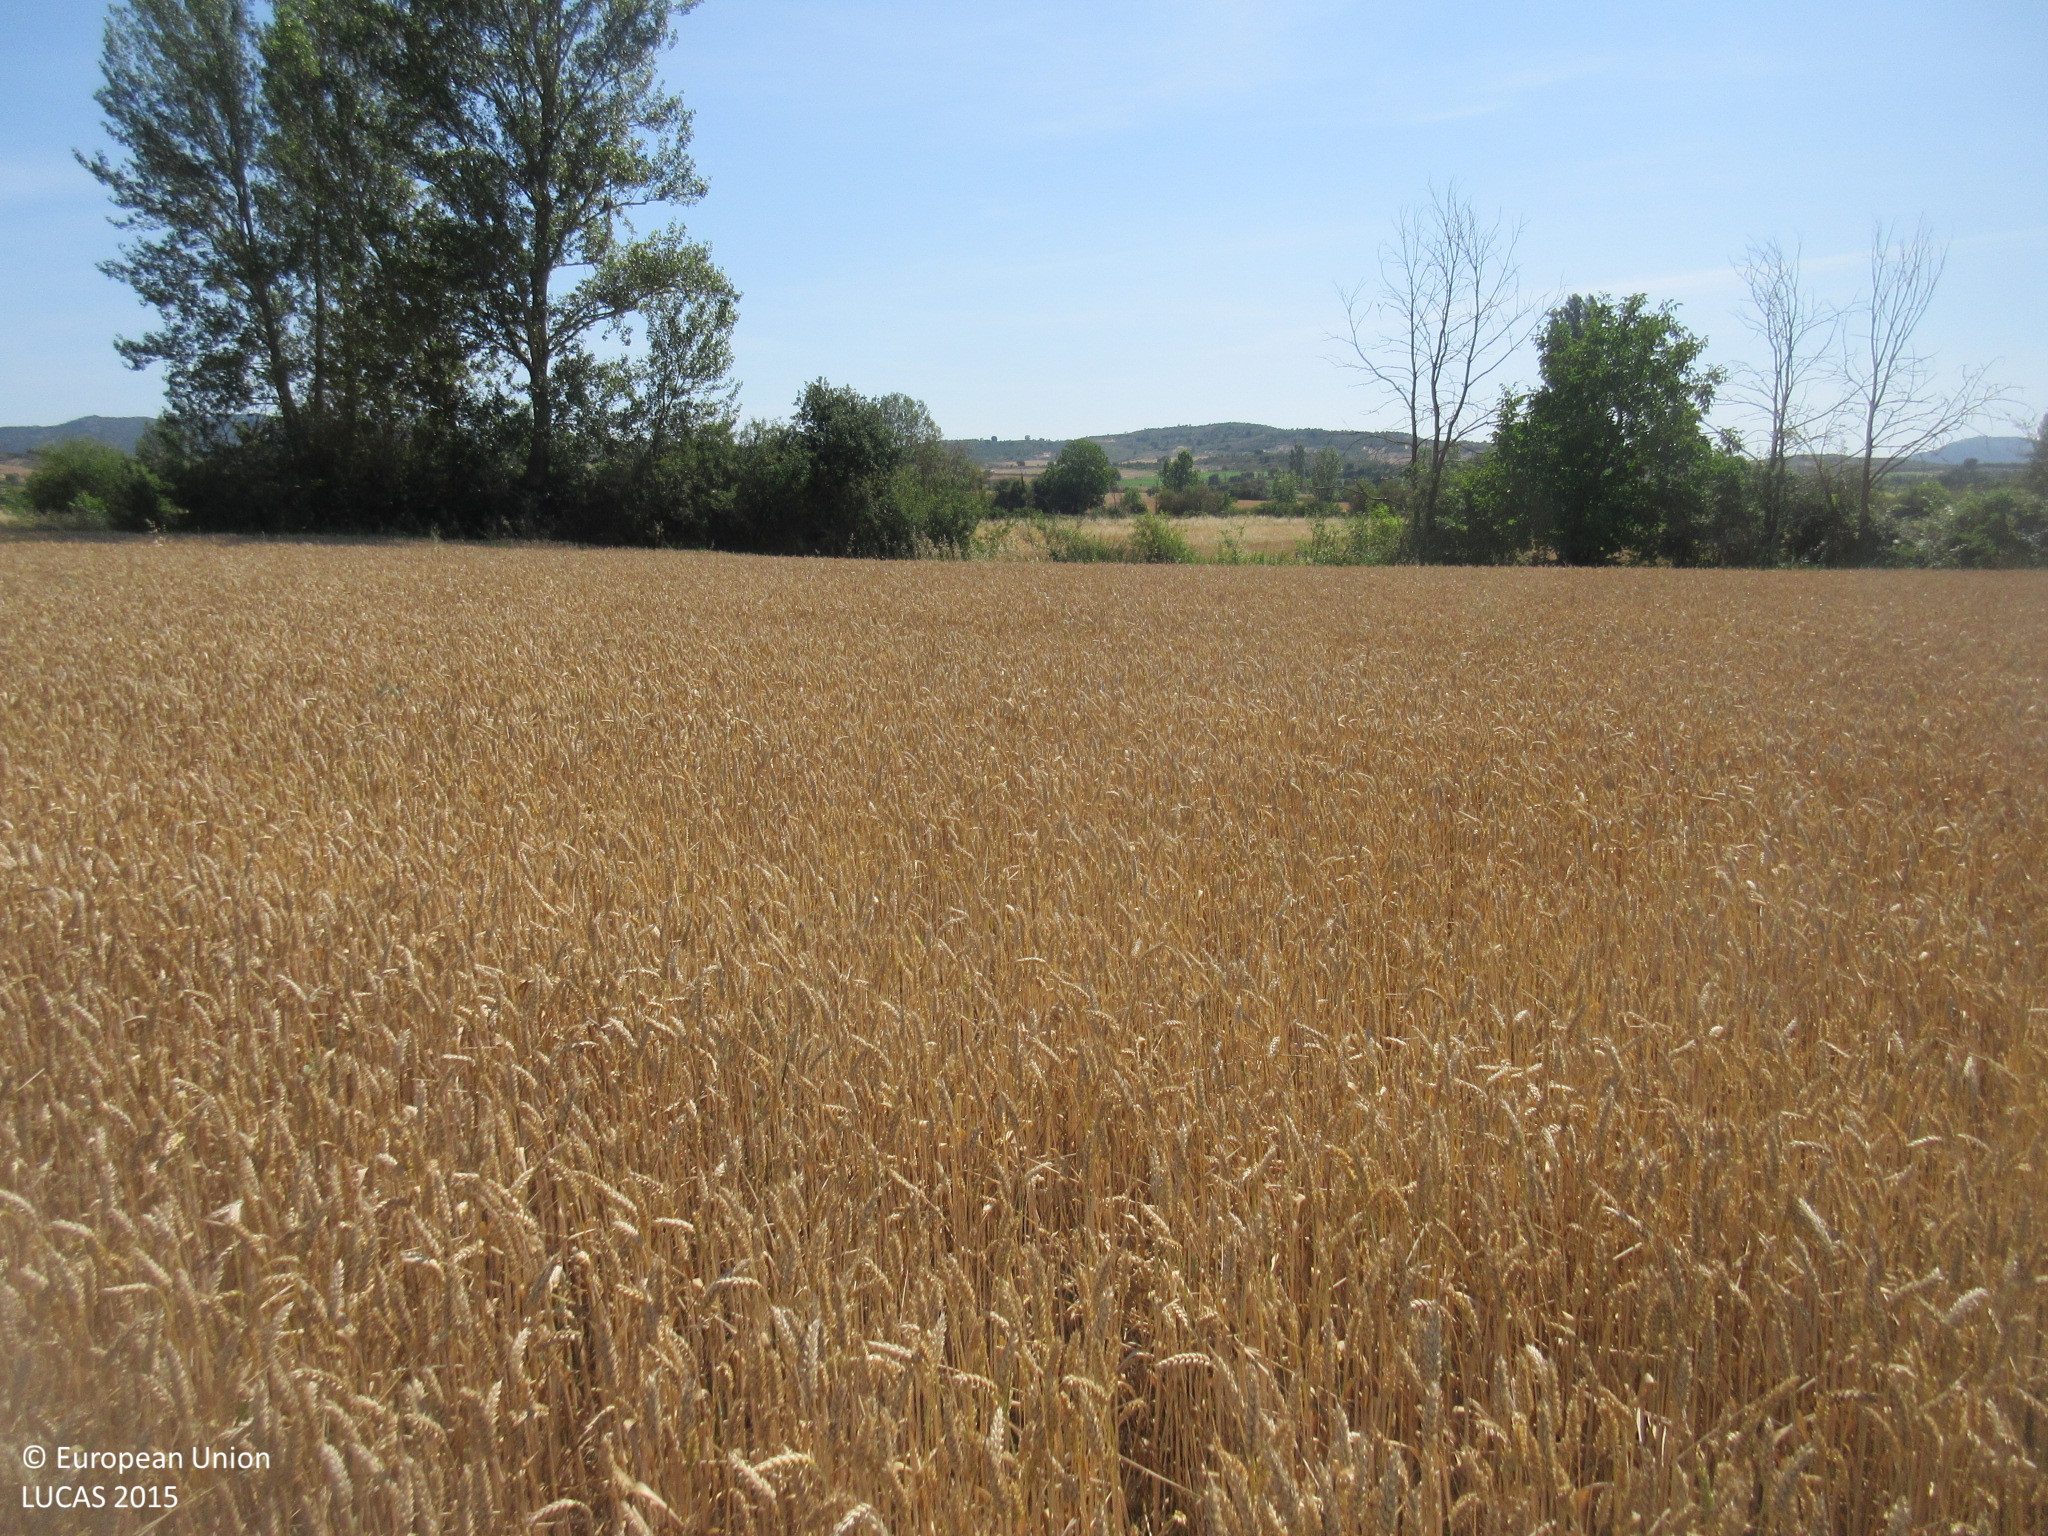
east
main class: Cropland
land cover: Common wheat
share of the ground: > 75 %
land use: Agriculture (excluding fallow land and kitchen gardens)
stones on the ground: < 10 %
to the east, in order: Common wheat; Grass margins; Ditches and canals; Common wheat; Barley; Abandoned hedges; Tracks; Abandoned hedges; Common wheat; Groves; Sunflower
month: July
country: ES
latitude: 42.9685
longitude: -3.5141
